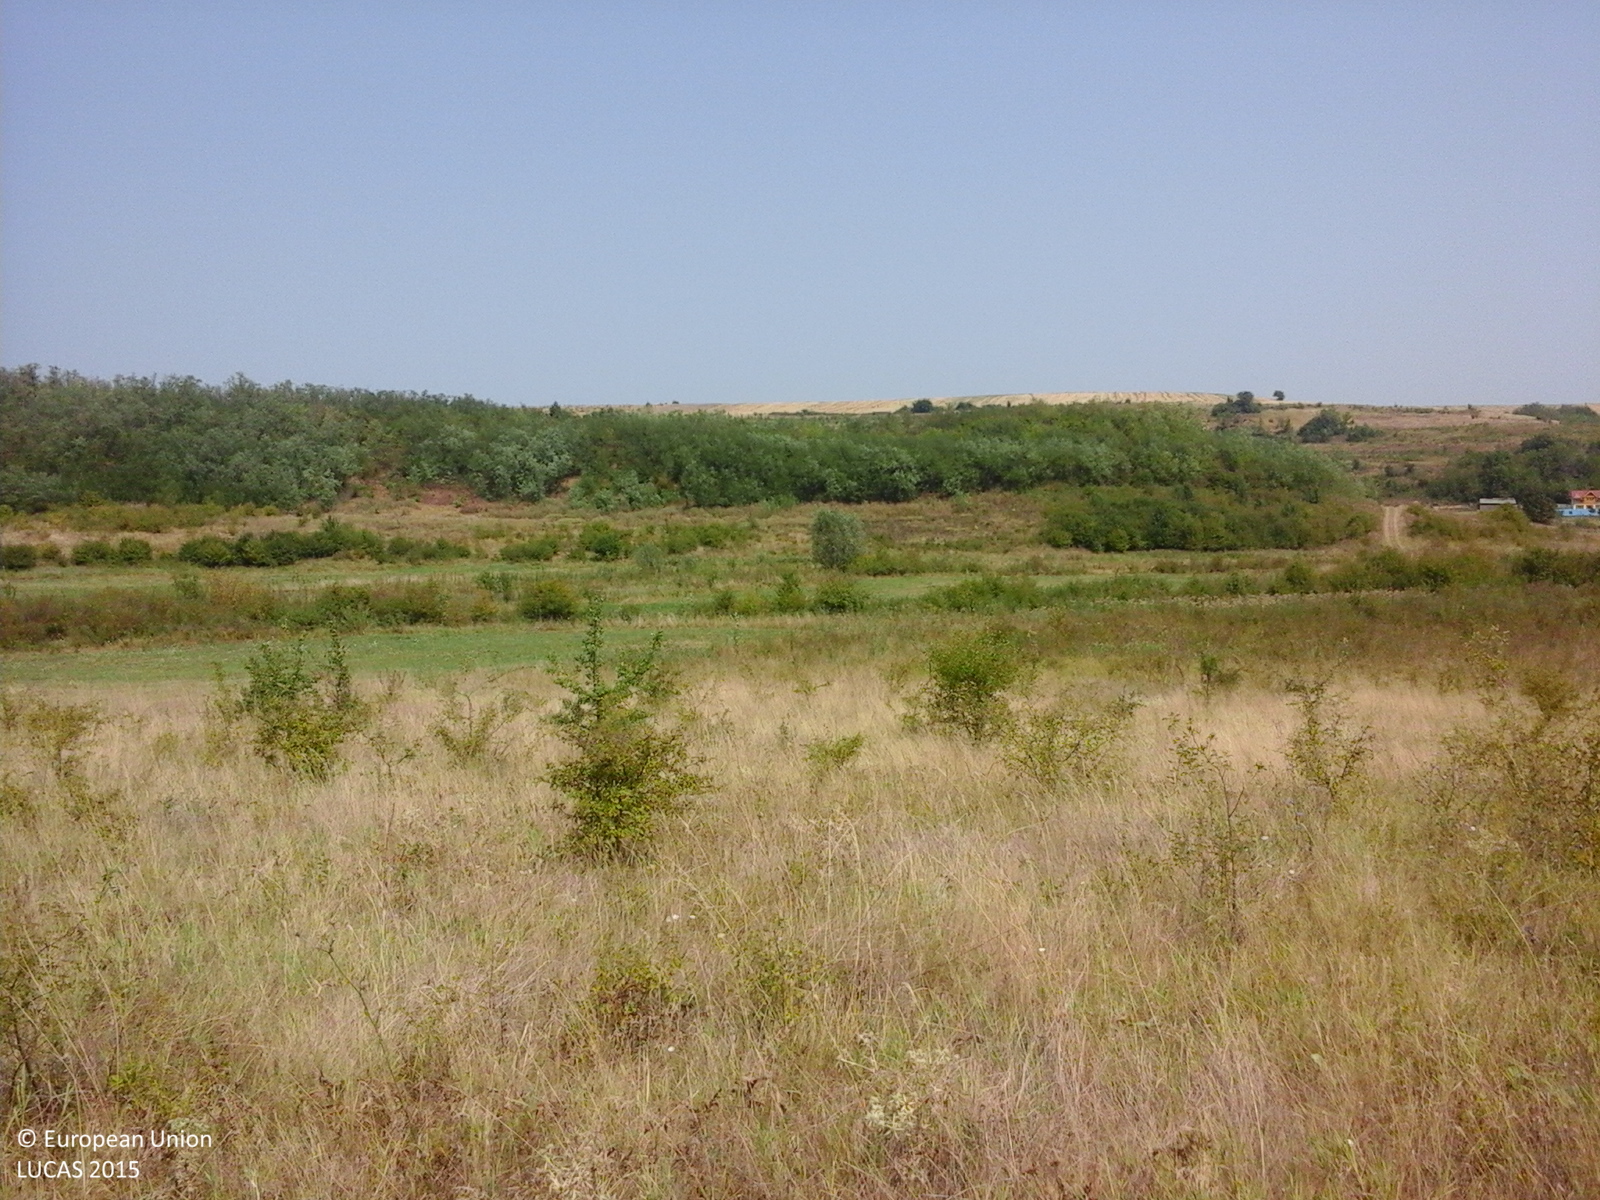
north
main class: Grassland
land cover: Spontaneously vegetated surfaces
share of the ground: > 75 %
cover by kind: herbaceous plants 100 %
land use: Fallow land
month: August
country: RO
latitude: 44.3762
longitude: 23.3662
